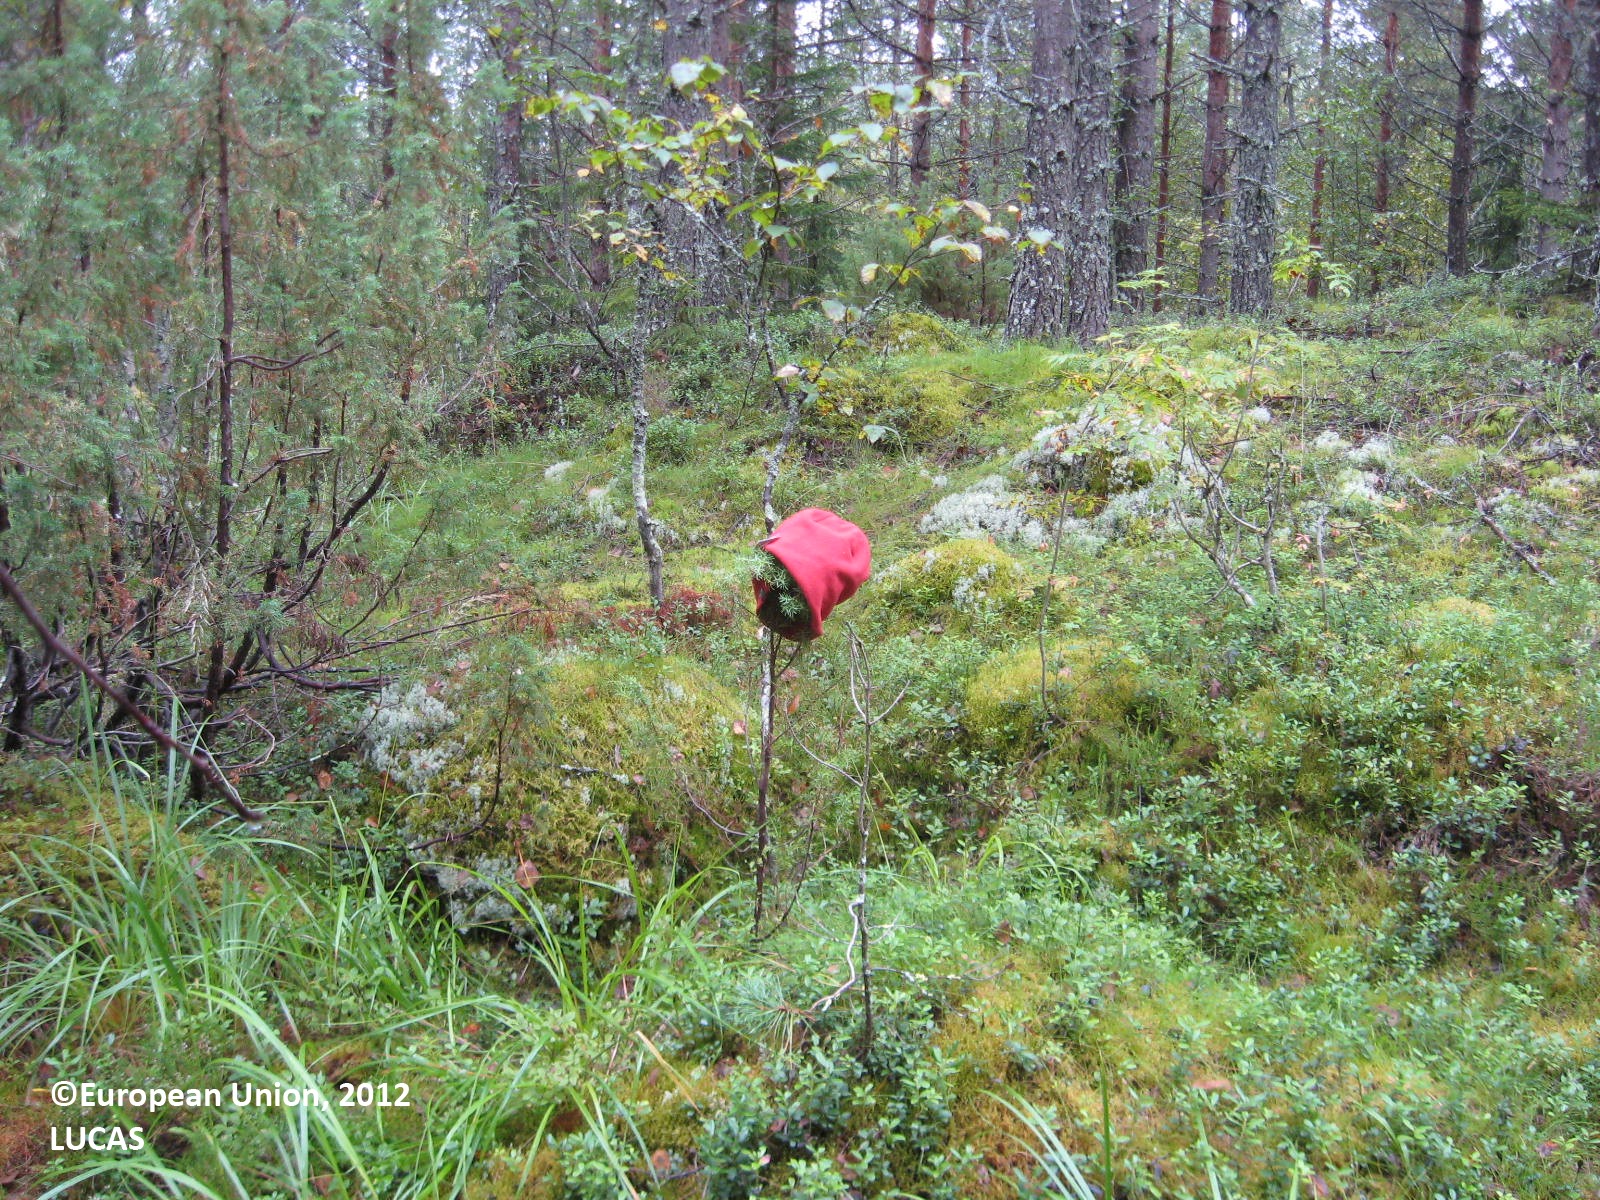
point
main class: Woodland
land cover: Pine dominated coniferous woodland
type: boreal forest
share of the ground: > 75 %
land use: Forestry
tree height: > 5 m
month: August
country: FI
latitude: 63.5104
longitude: 29.4564
